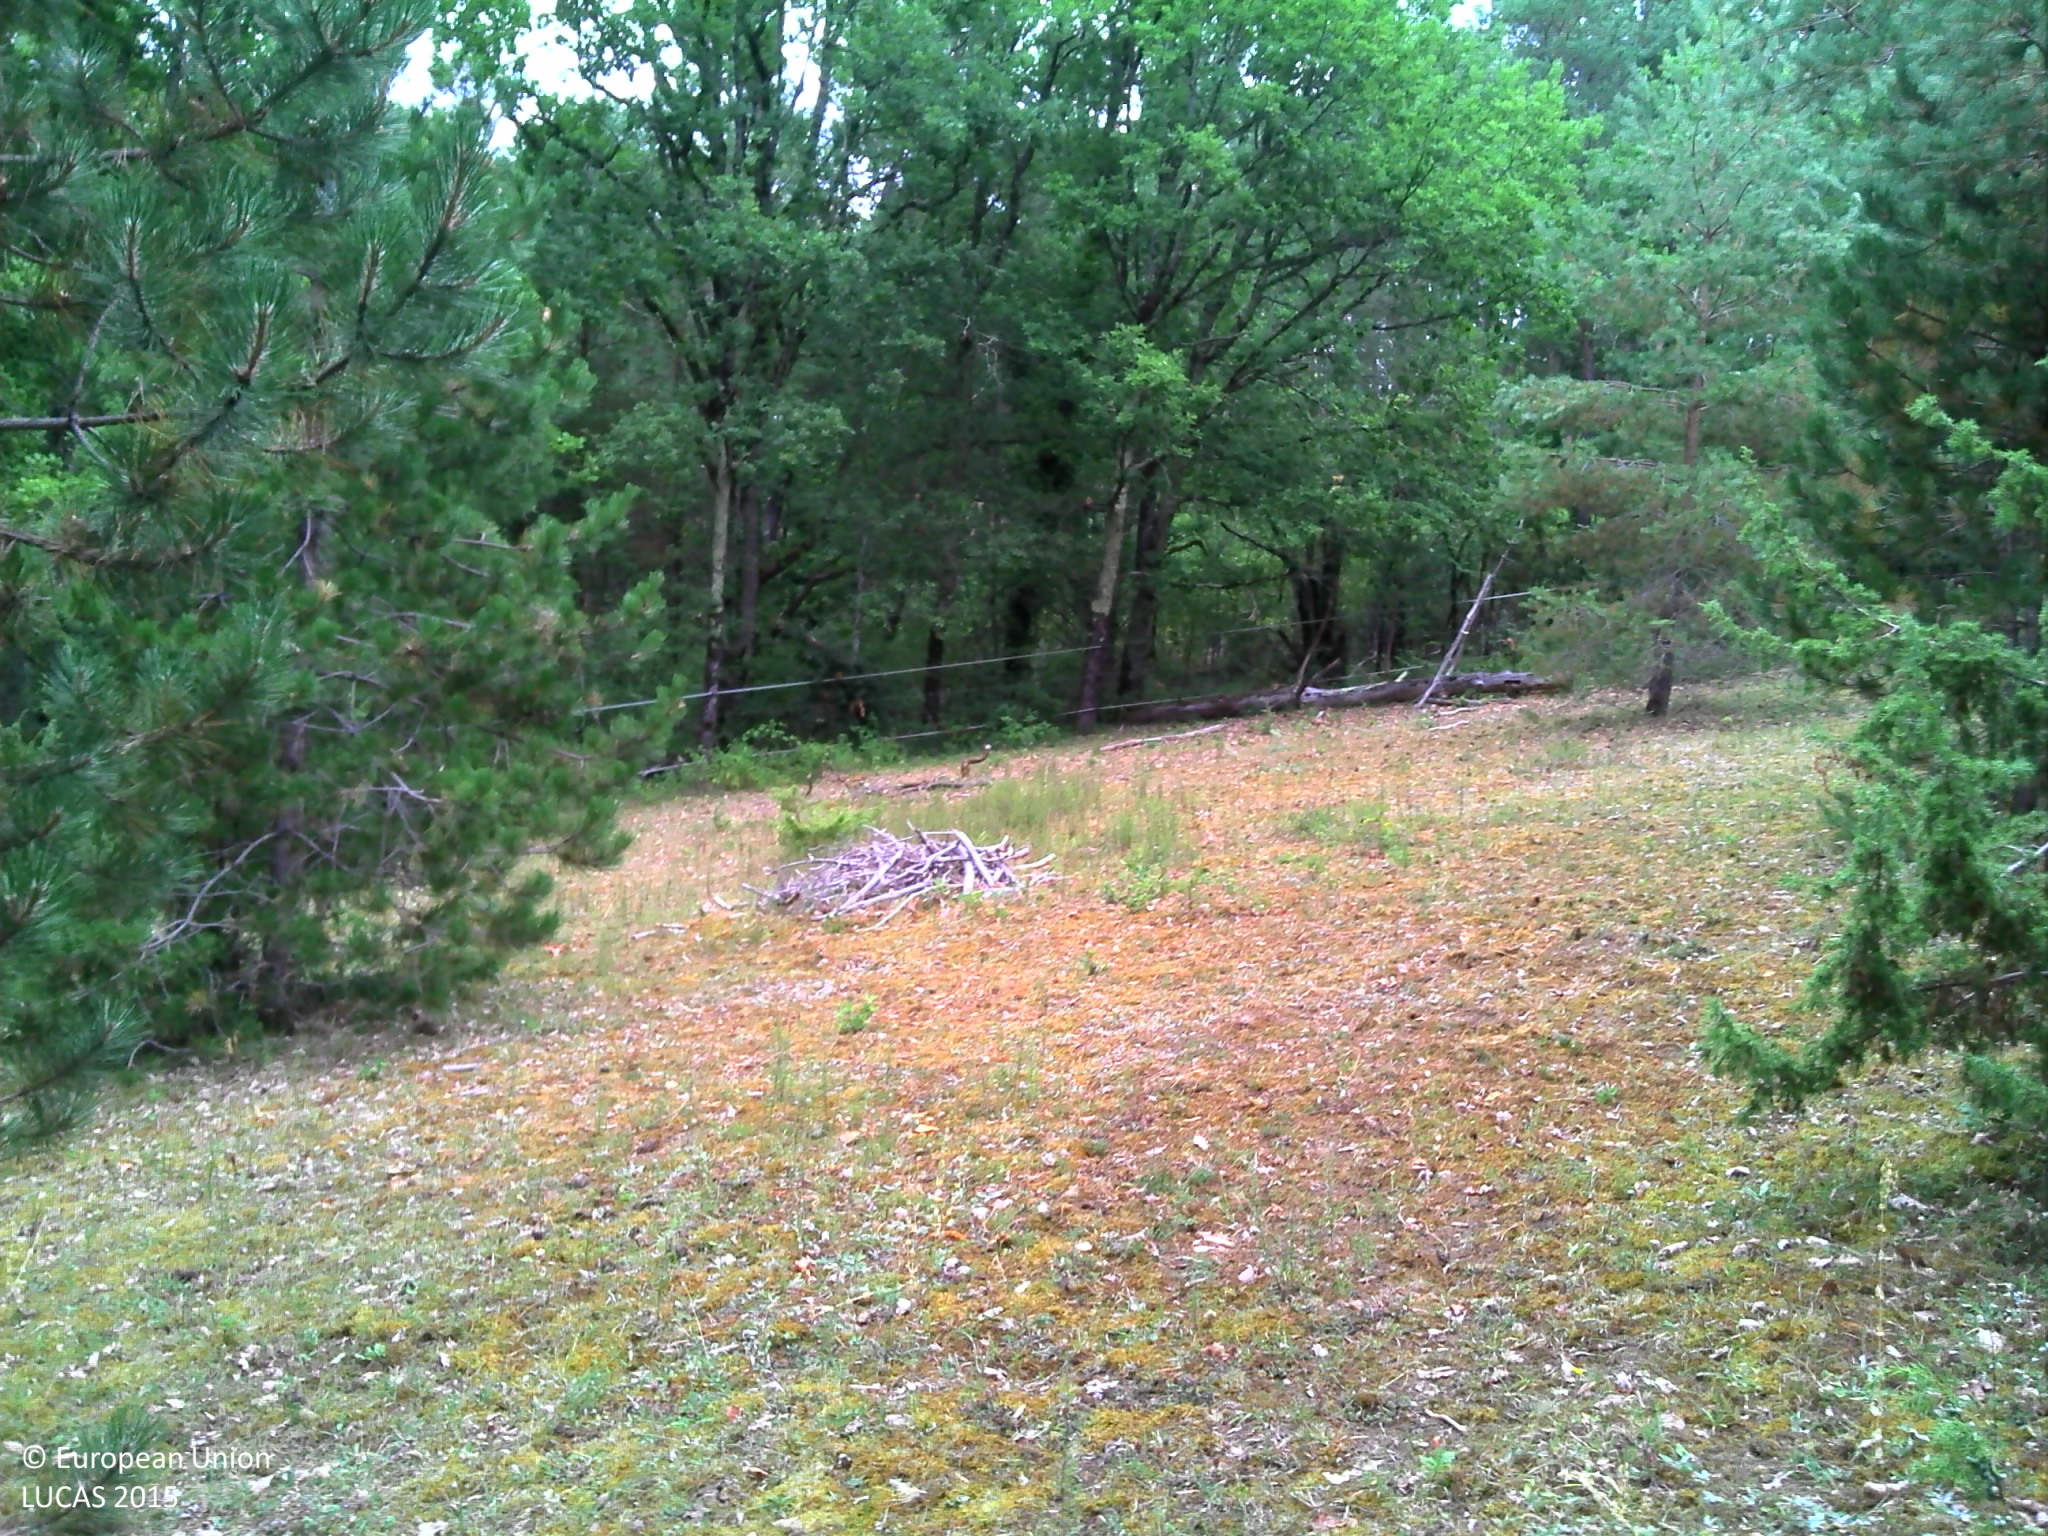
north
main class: Woodland
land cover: Pine dominated mixed woodland
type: hemiboreal forest and nemoral coniferous forest and mixed broadleaved-coniferous forest
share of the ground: > 75 %
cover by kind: broadleaved forest trees 55 %, coniferous forest trees 20 %, lichens and mosses 20 %, herbaceous plants 5 %
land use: Agriculture (excluding fallow land and kitchen gardens)
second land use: Forestry
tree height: > 5 m
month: July
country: FR
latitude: 45.1825
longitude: 0.8920
